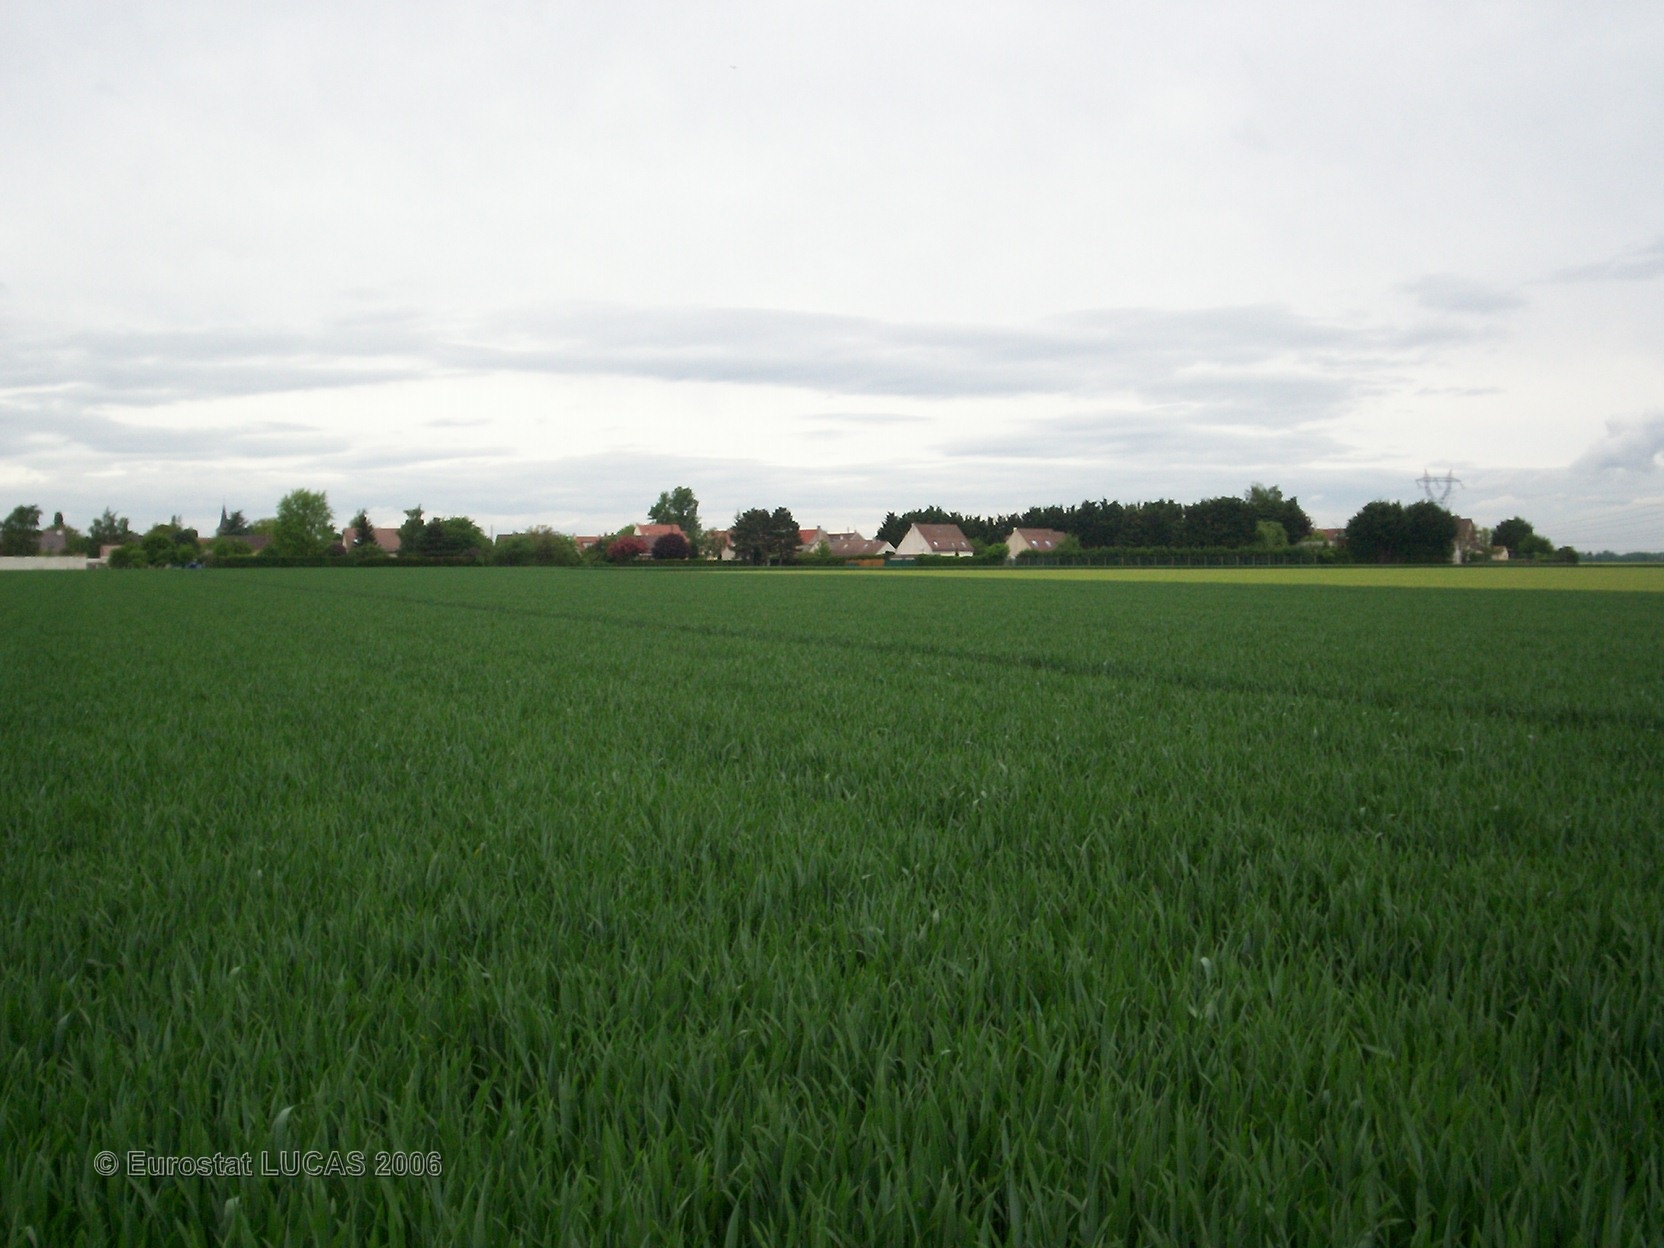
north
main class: Cropland
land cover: Common wheat
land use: Agriculture (excluding fallow land and kitchen gardens)
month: May
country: FR
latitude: 48.6159
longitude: 2.7333
